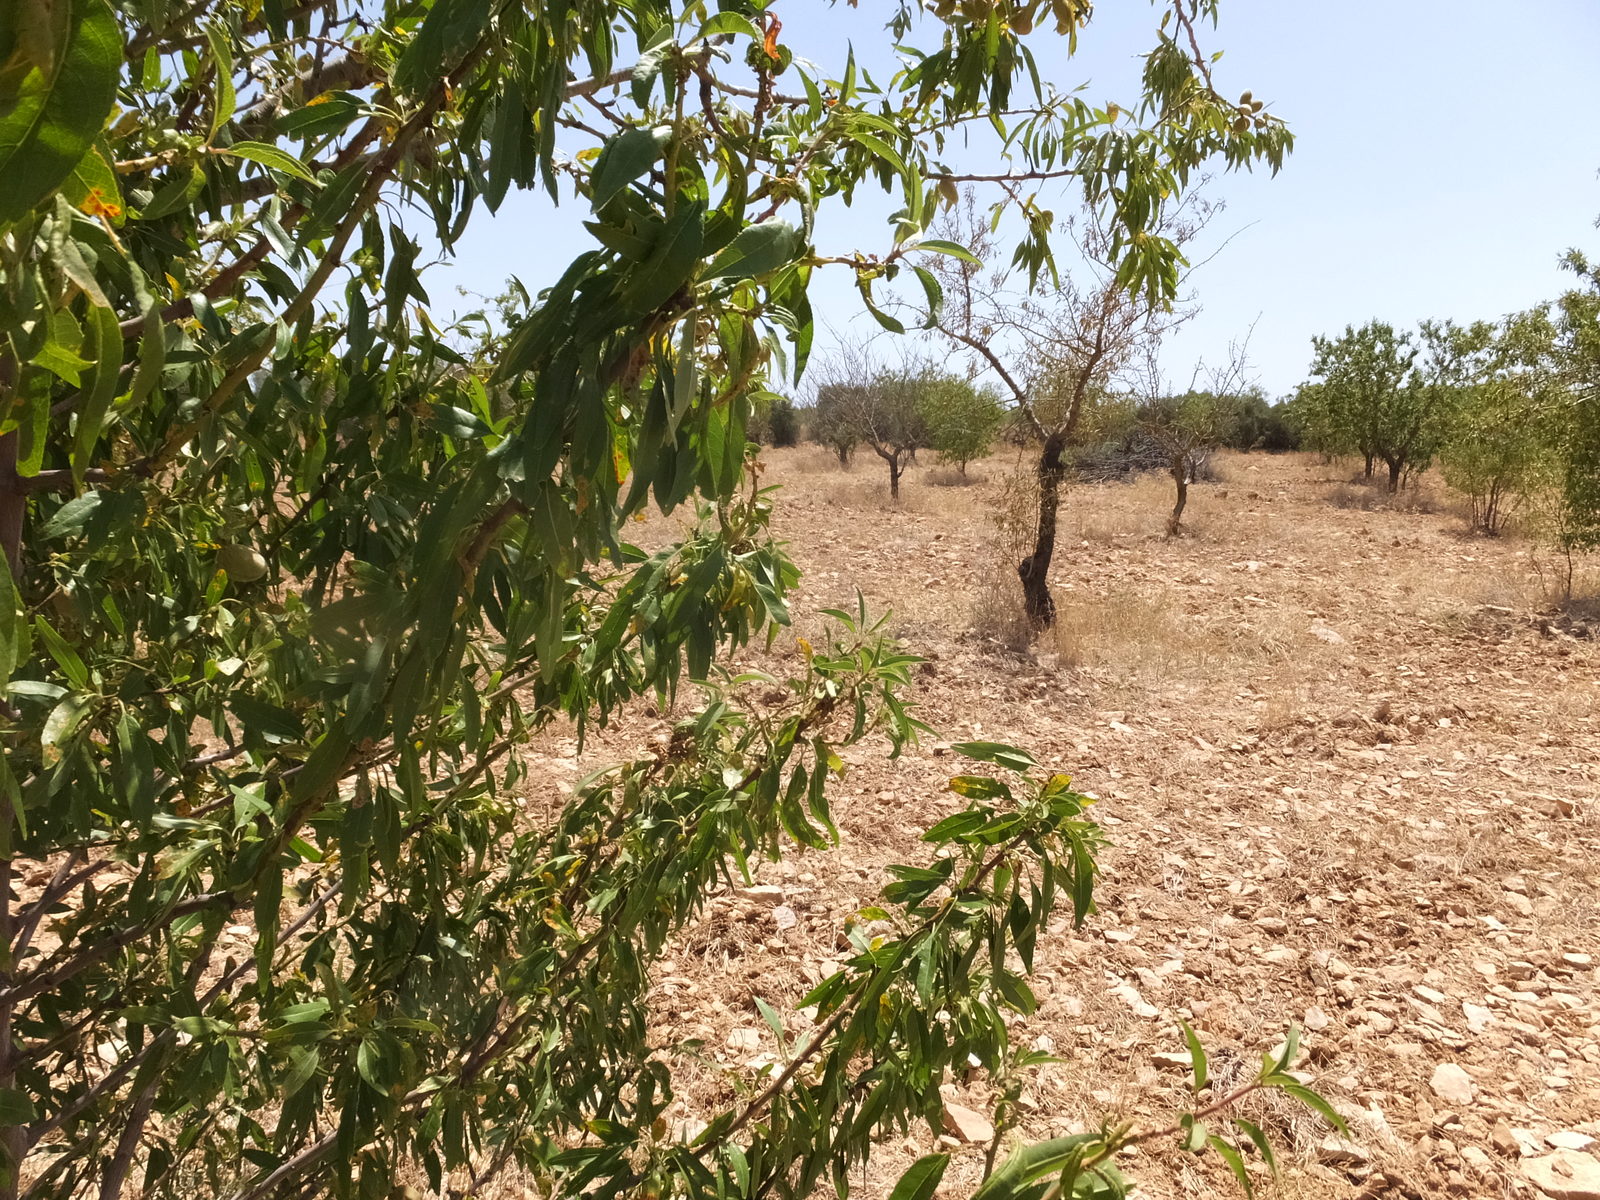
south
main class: Cropland
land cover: Nuts trees
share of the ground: 25 - 50 %
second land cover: Other bare soil
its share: > 75 %
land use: Agriculture (excluding fallow land and kitchen gardens)
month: July
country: ES
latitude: 41.4382
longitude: 0.4497
